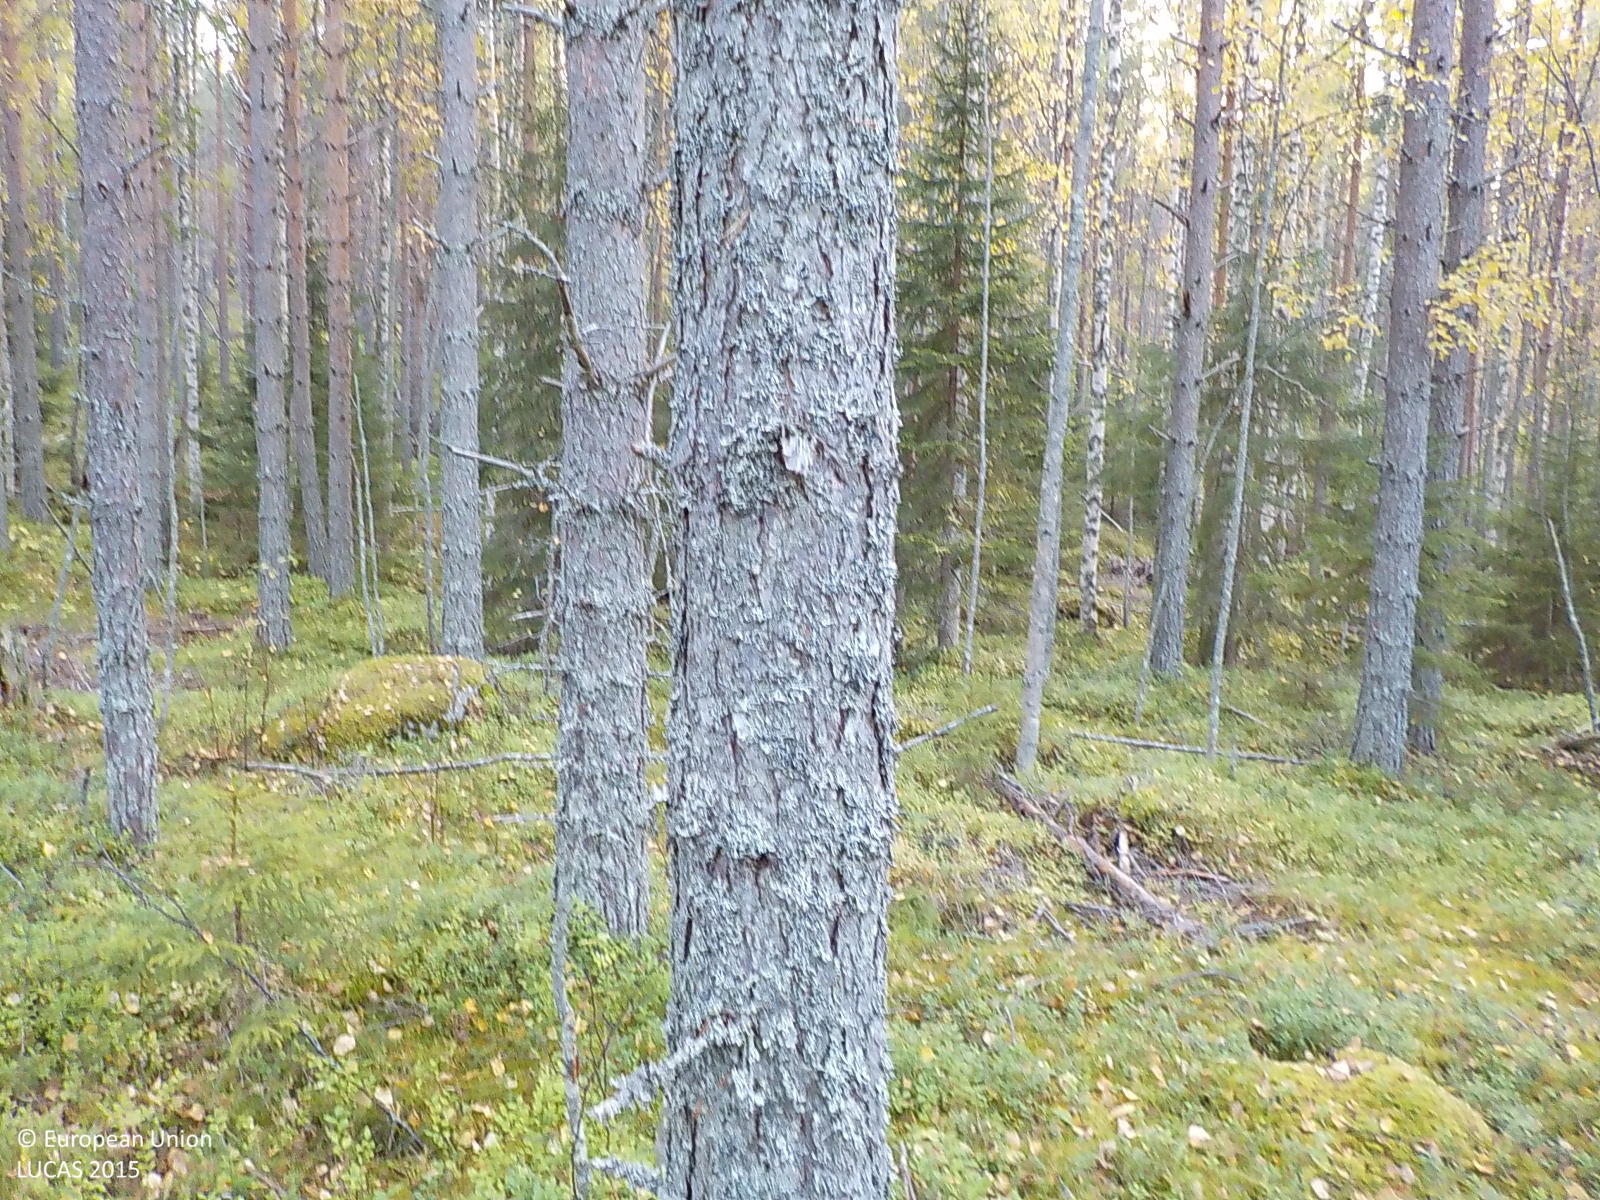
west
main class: Woodland
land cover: Pine dominated coniferous woodland
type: boreal forest
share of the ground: 50 - 75 %
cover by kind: coniferous forest trees 75 %, shrubs 25 %
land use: Forestry
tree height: > 5 m
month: September
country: SE
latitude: 63.4795
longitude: 17.0597
